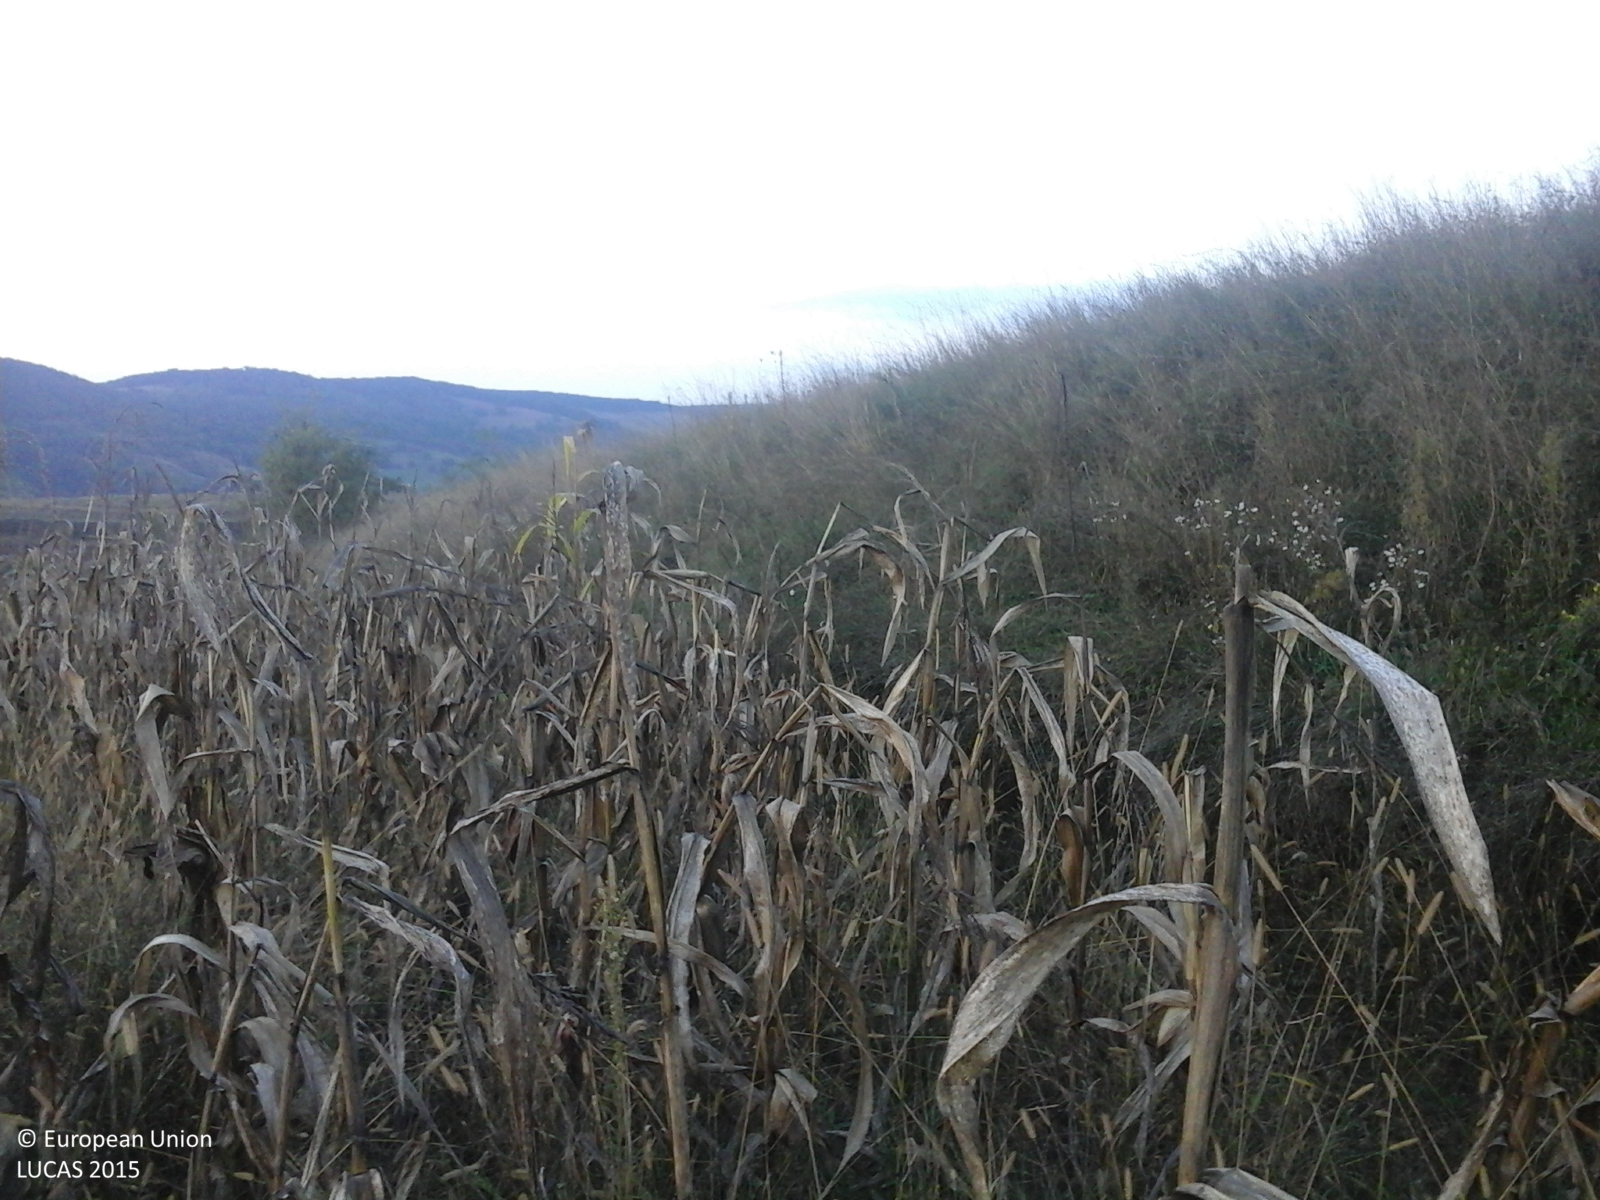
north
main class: Cropland
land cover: Maize
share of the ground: > 75 %
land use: Agriculture (excluding fallow land and kitchen gardens)
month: October
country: RO
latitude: 46.0234
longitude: 24.1703
